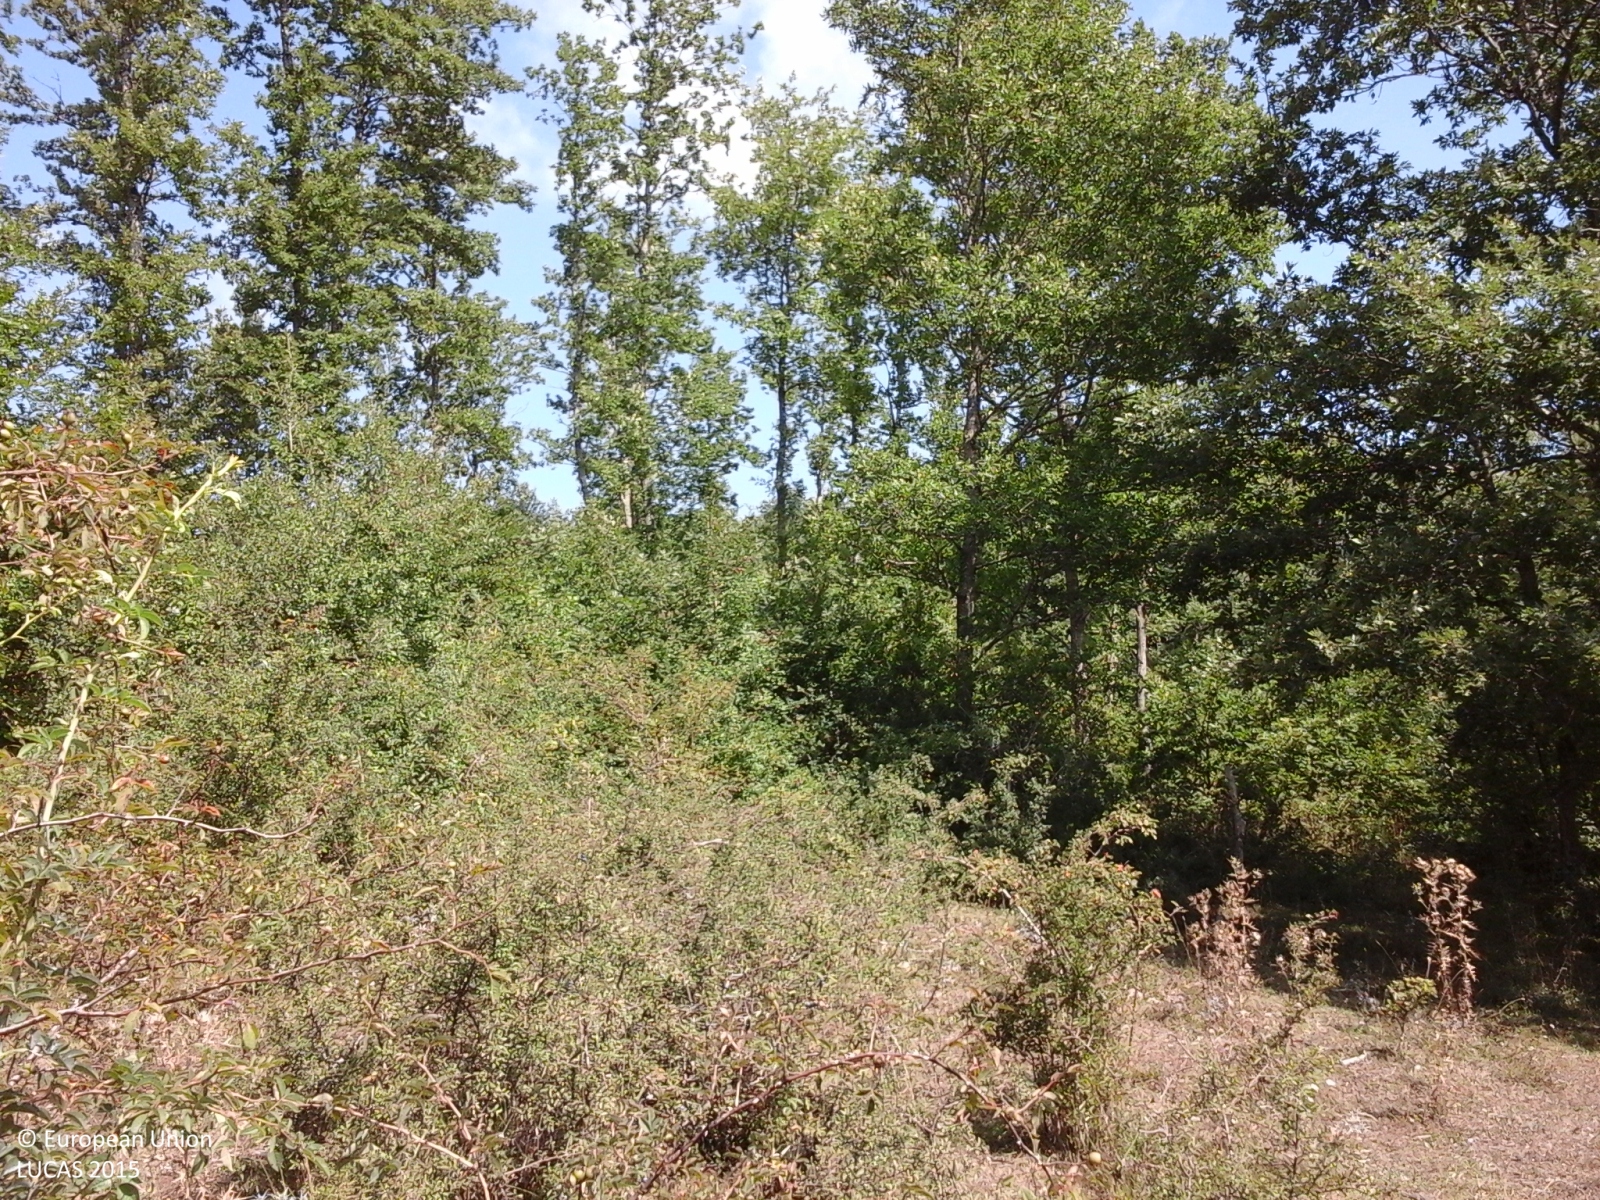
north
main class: Shrubland
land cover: Shrubland with sparse tree cover
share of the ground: > 75 %
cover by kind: herbaceous plants 50 %, shrubs 45 %, broadleaved forest trees 5 %
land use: Agriculture (excluding fallow land and kitchen gardens)
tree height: < 5 m
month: August
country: IT
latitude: 41.7666
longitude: 14.3036
